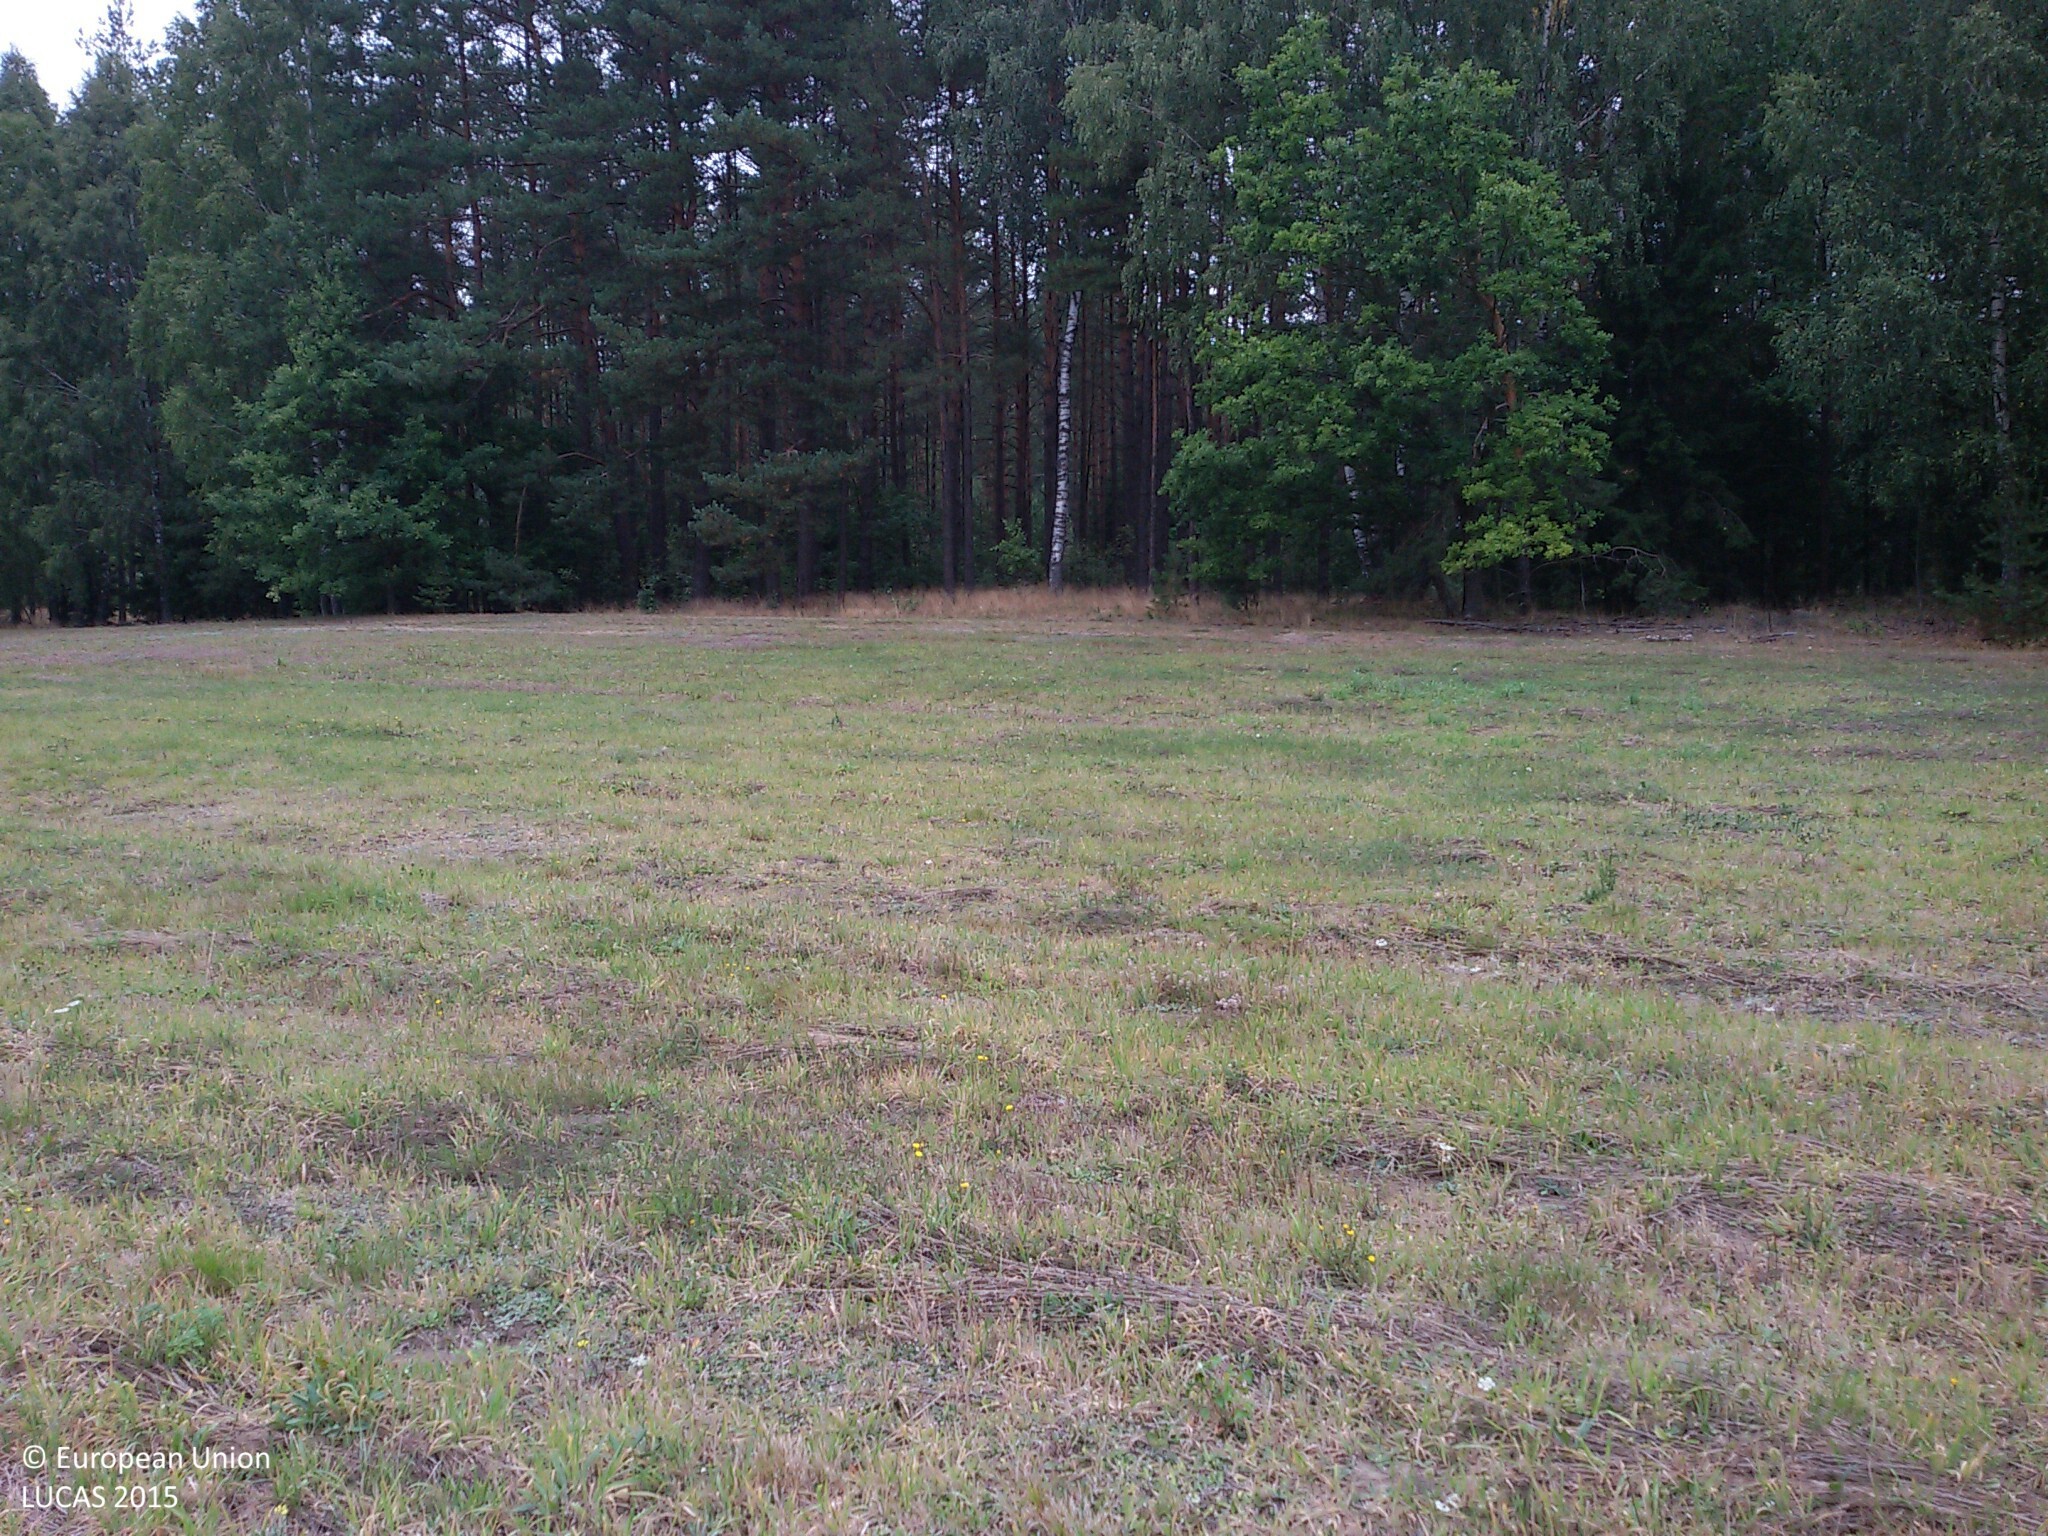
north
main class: Grassland
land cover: Grassland without tree/shrub cover
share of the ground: > 75 %
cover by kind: herbaceous plants 90 %, unconsolidated bare surface 10 %
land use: Agriculture (excluding fallow land and kitchen gardens)
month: September
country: PL
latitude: 53.7666
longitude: 20.2133
